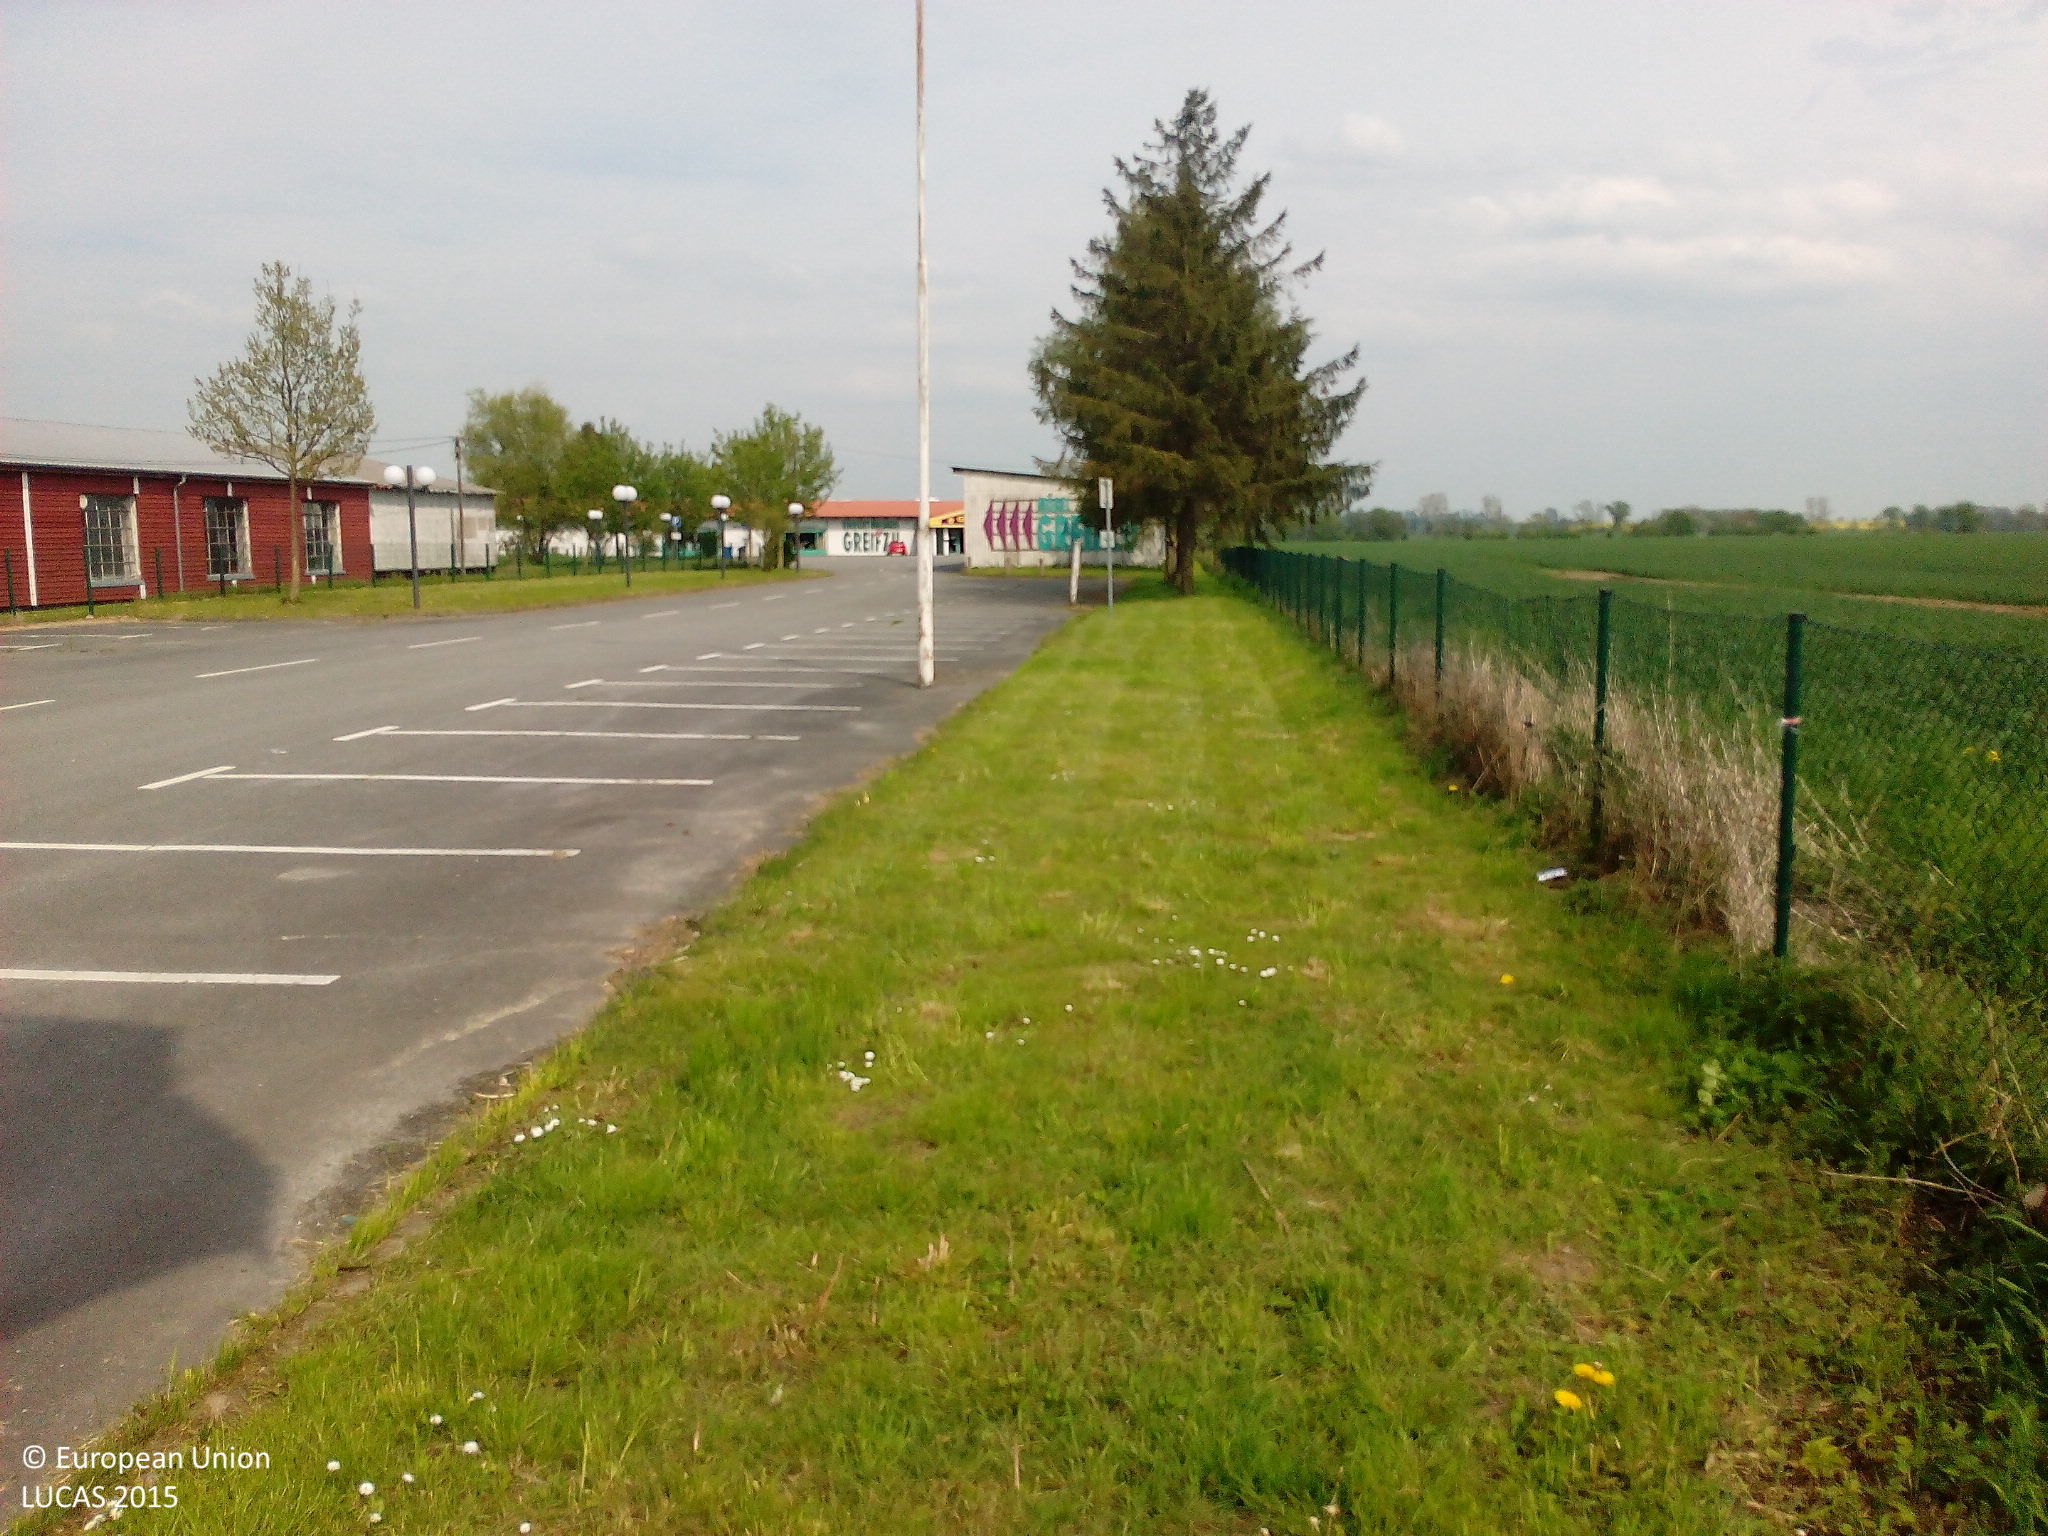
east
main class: Artificial land
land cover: Non built-up area features
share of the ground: > 75 %
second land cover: Grassland without tree/shrub cover
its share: > 75 %
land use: Commerce
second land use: Road transport
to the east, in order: Artificial constructions in urban areas; Grassland without tree/shrub cover; Lines of trees; Fences; Spontaneously vegetated surfaces; Triticale
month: May
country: DE
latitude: 54.2886
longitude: 12.7181
